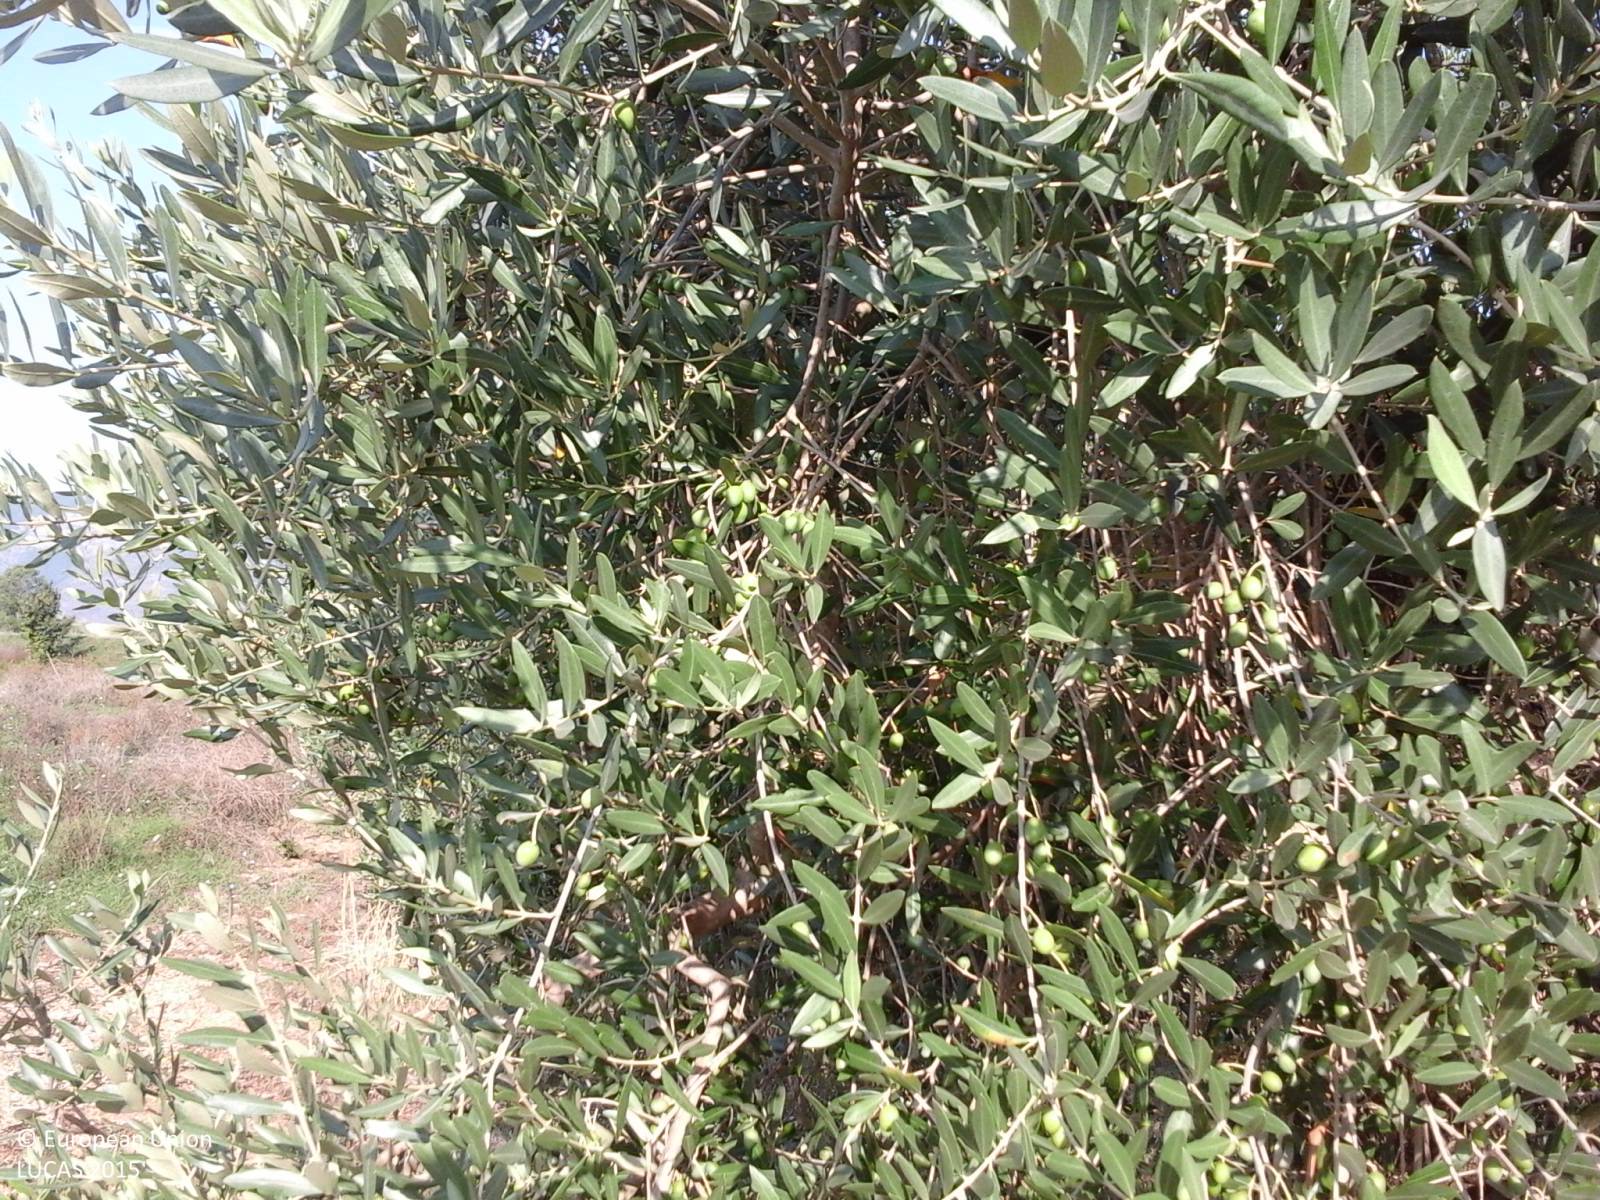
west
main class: Cropland
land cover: Olive groves
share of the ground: > 75 %
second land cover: Spontaneously vegetated surfaces
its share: > 75 %
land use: Agriculture (excluding fallow land and kitchen gardens)
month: August
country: IT
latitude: 41.3321
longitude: 13.3680
